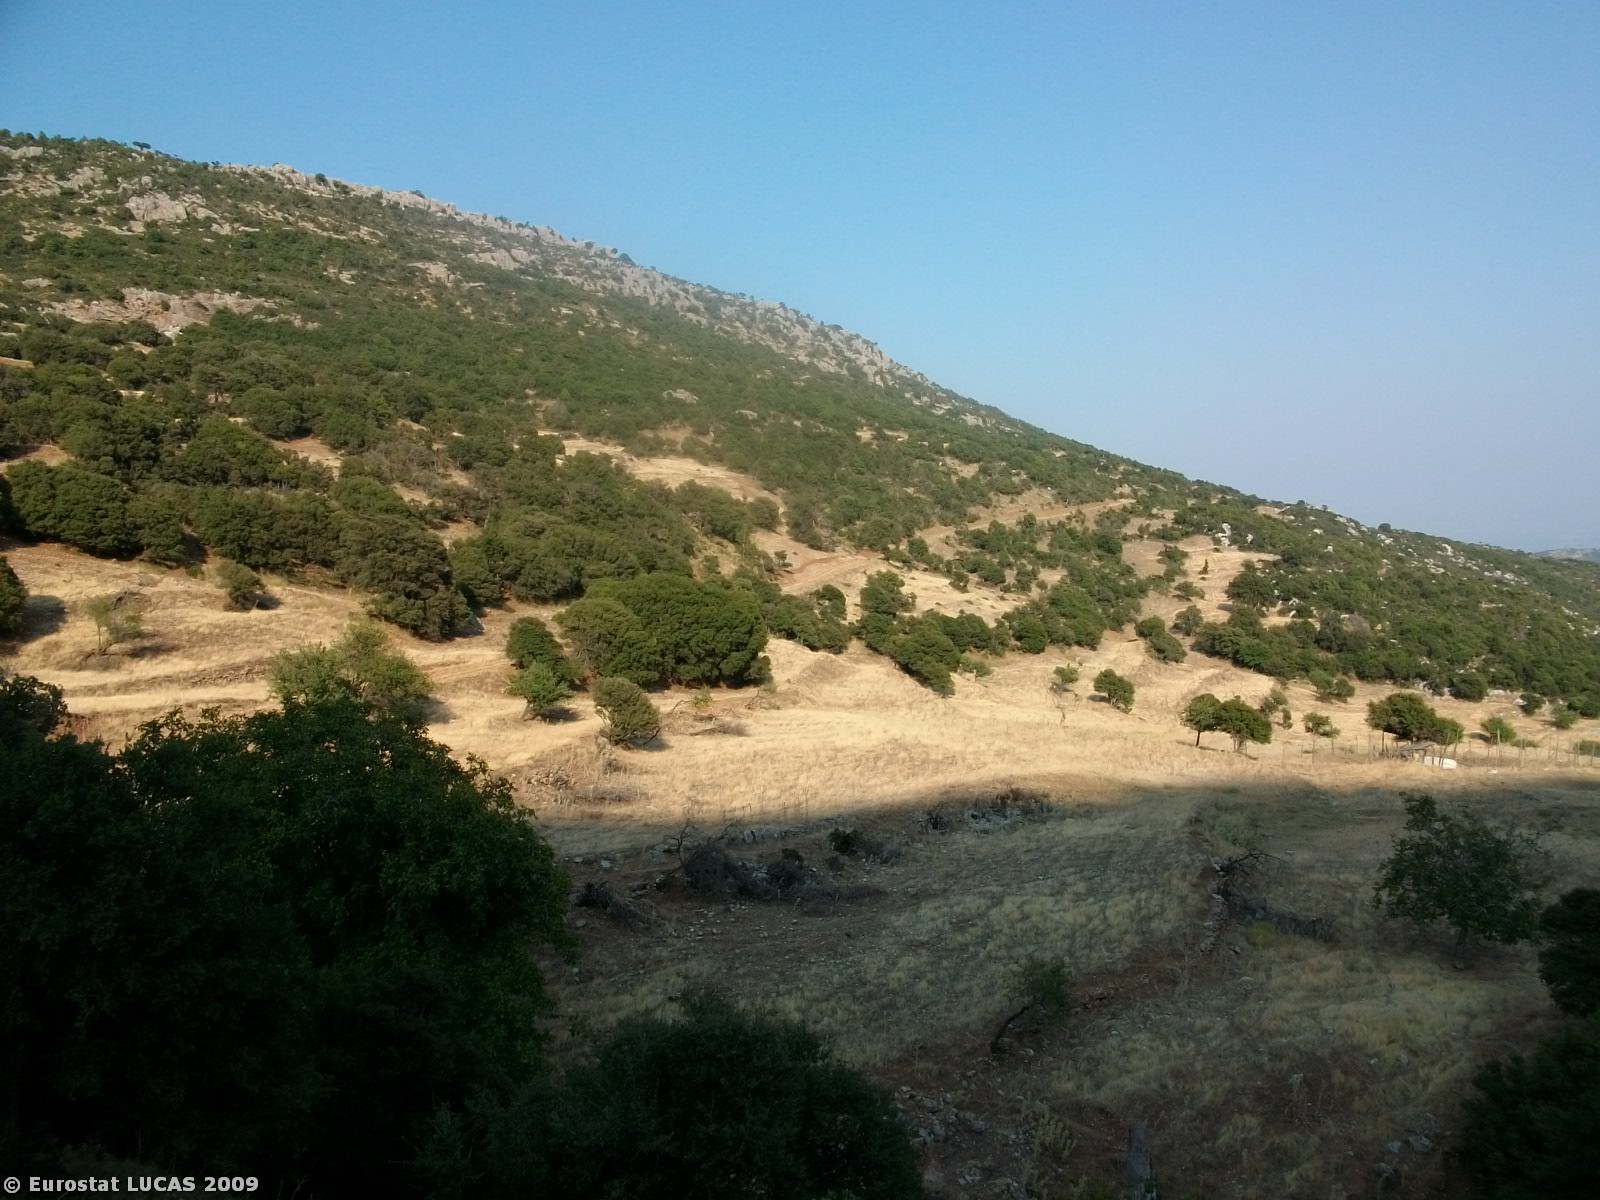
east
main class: Bare land
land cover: Bare land
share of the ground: 50 - 75 %
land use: Road transport
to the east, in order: Bare land; Shrubland with sparse tree cover; Tracks; Grassland with sparse tree/shrub cover; Rivers and streams; Grassland with sparse tree/shrub cover; Broadleaved woodland; Grassland with sparse tree/shrub cover
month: August
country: GR
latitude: 37.7431
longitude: 22.5060
